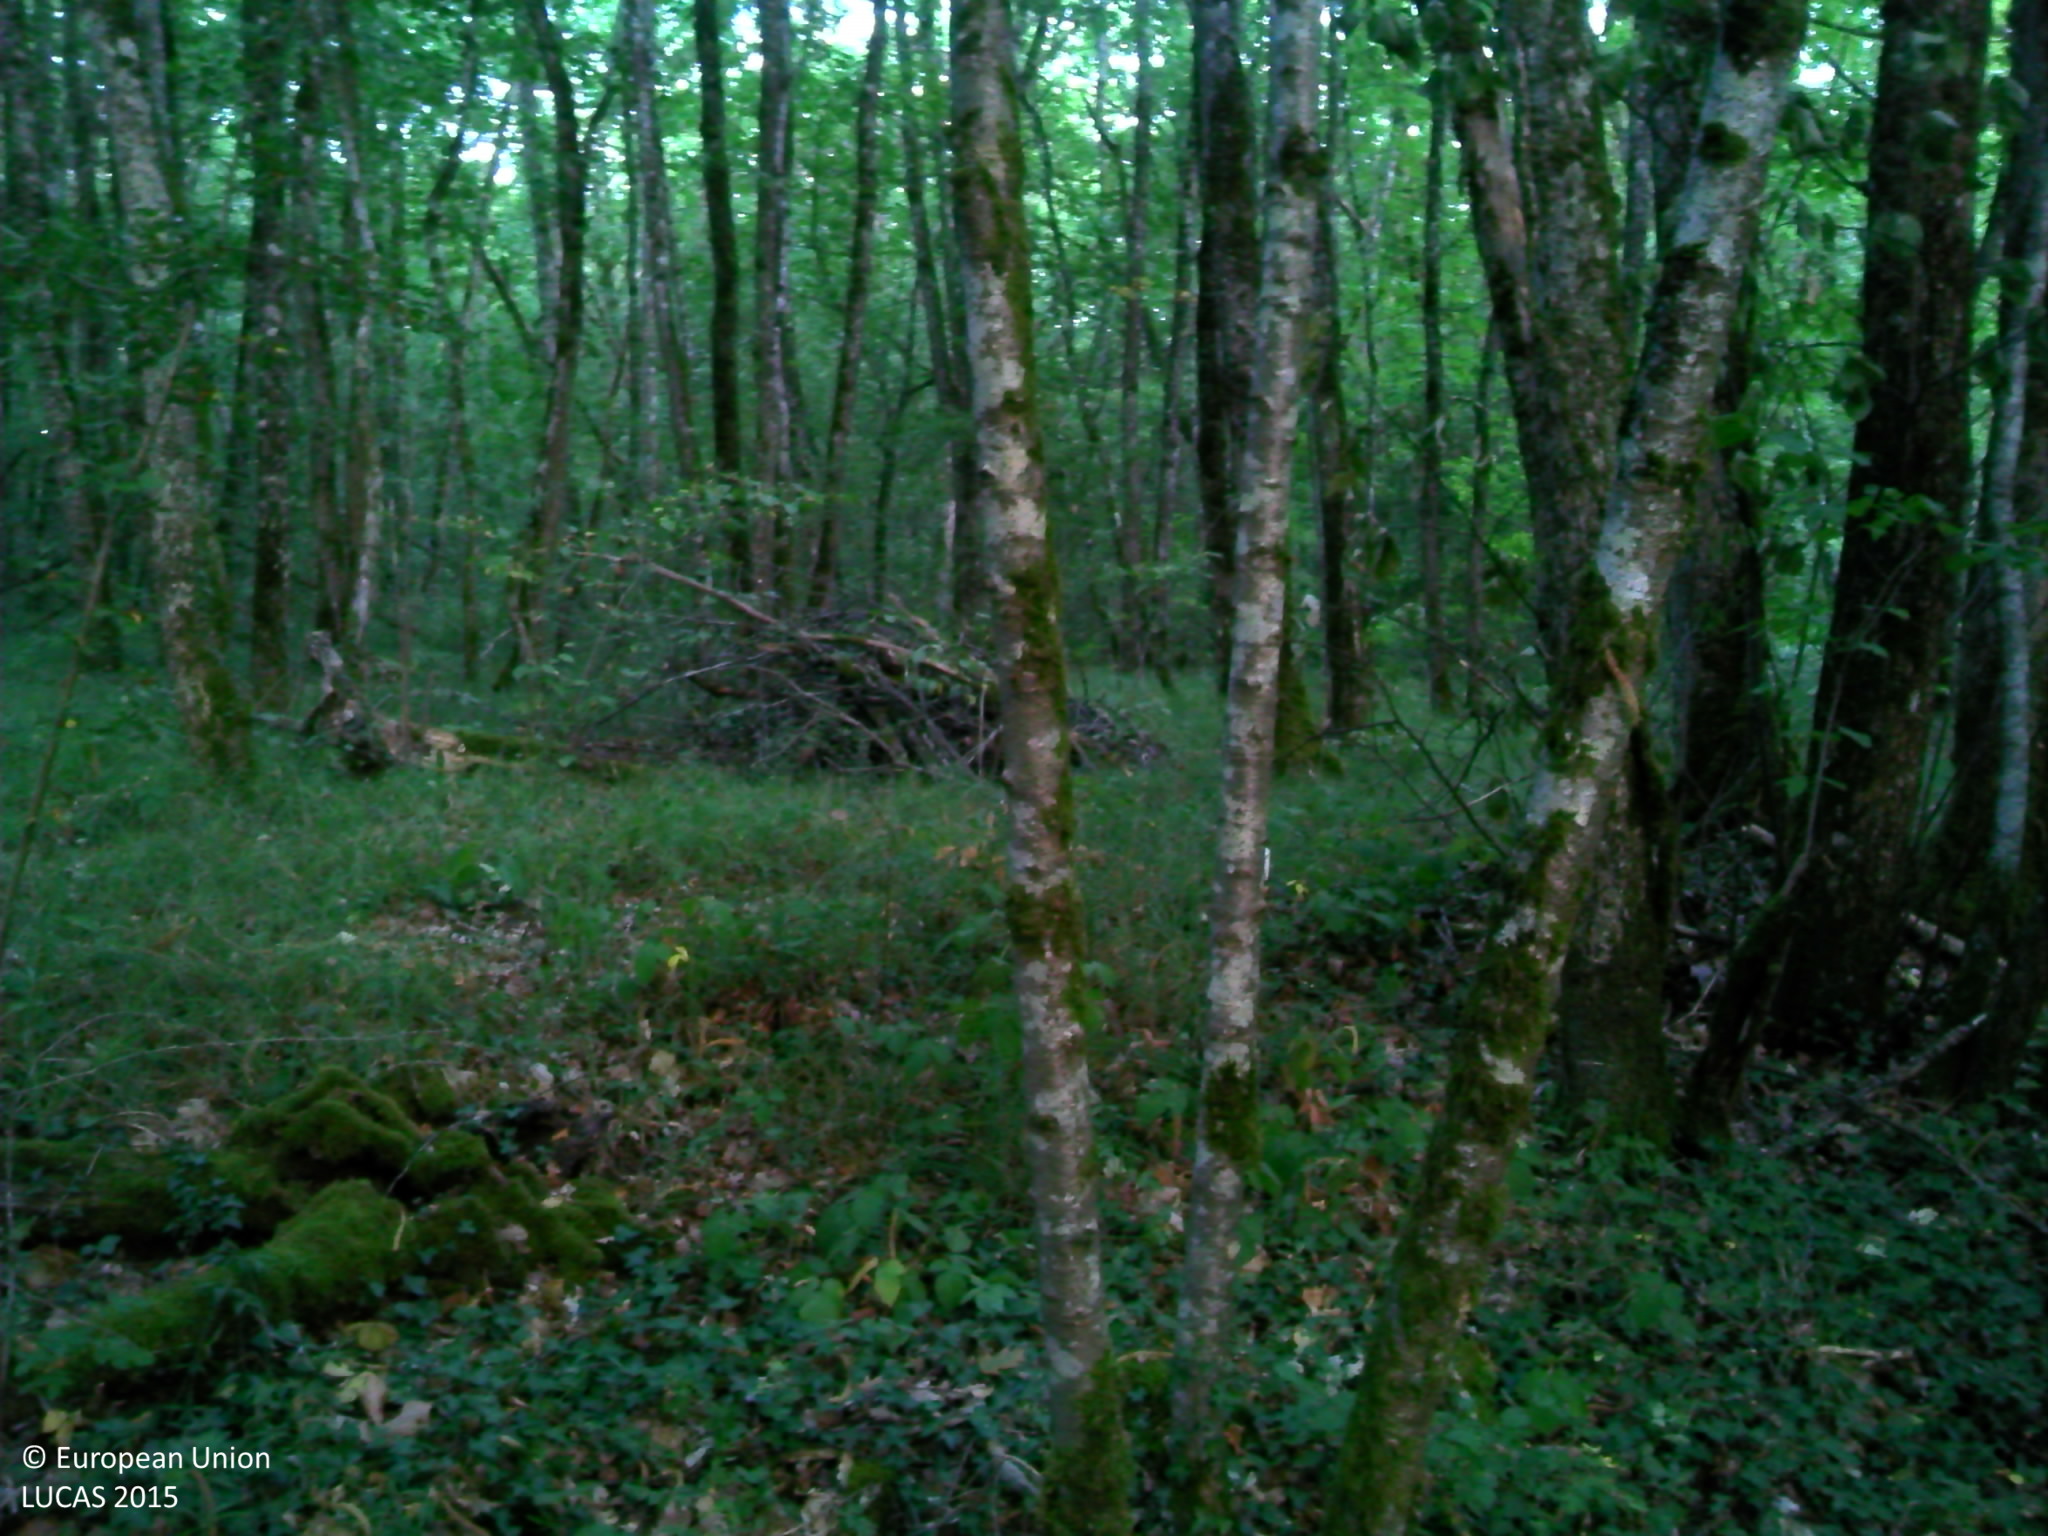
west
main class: Woodland
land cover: Broadleaved woodland
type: thermophilous deciduous forest
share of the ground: > 75 %
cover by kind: broadleaved forest trees 90 %, herbaceous plants 10 %
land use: Forestry
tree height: > 5 m
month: July
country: FR
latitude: 44.3270
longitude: 0.6519
